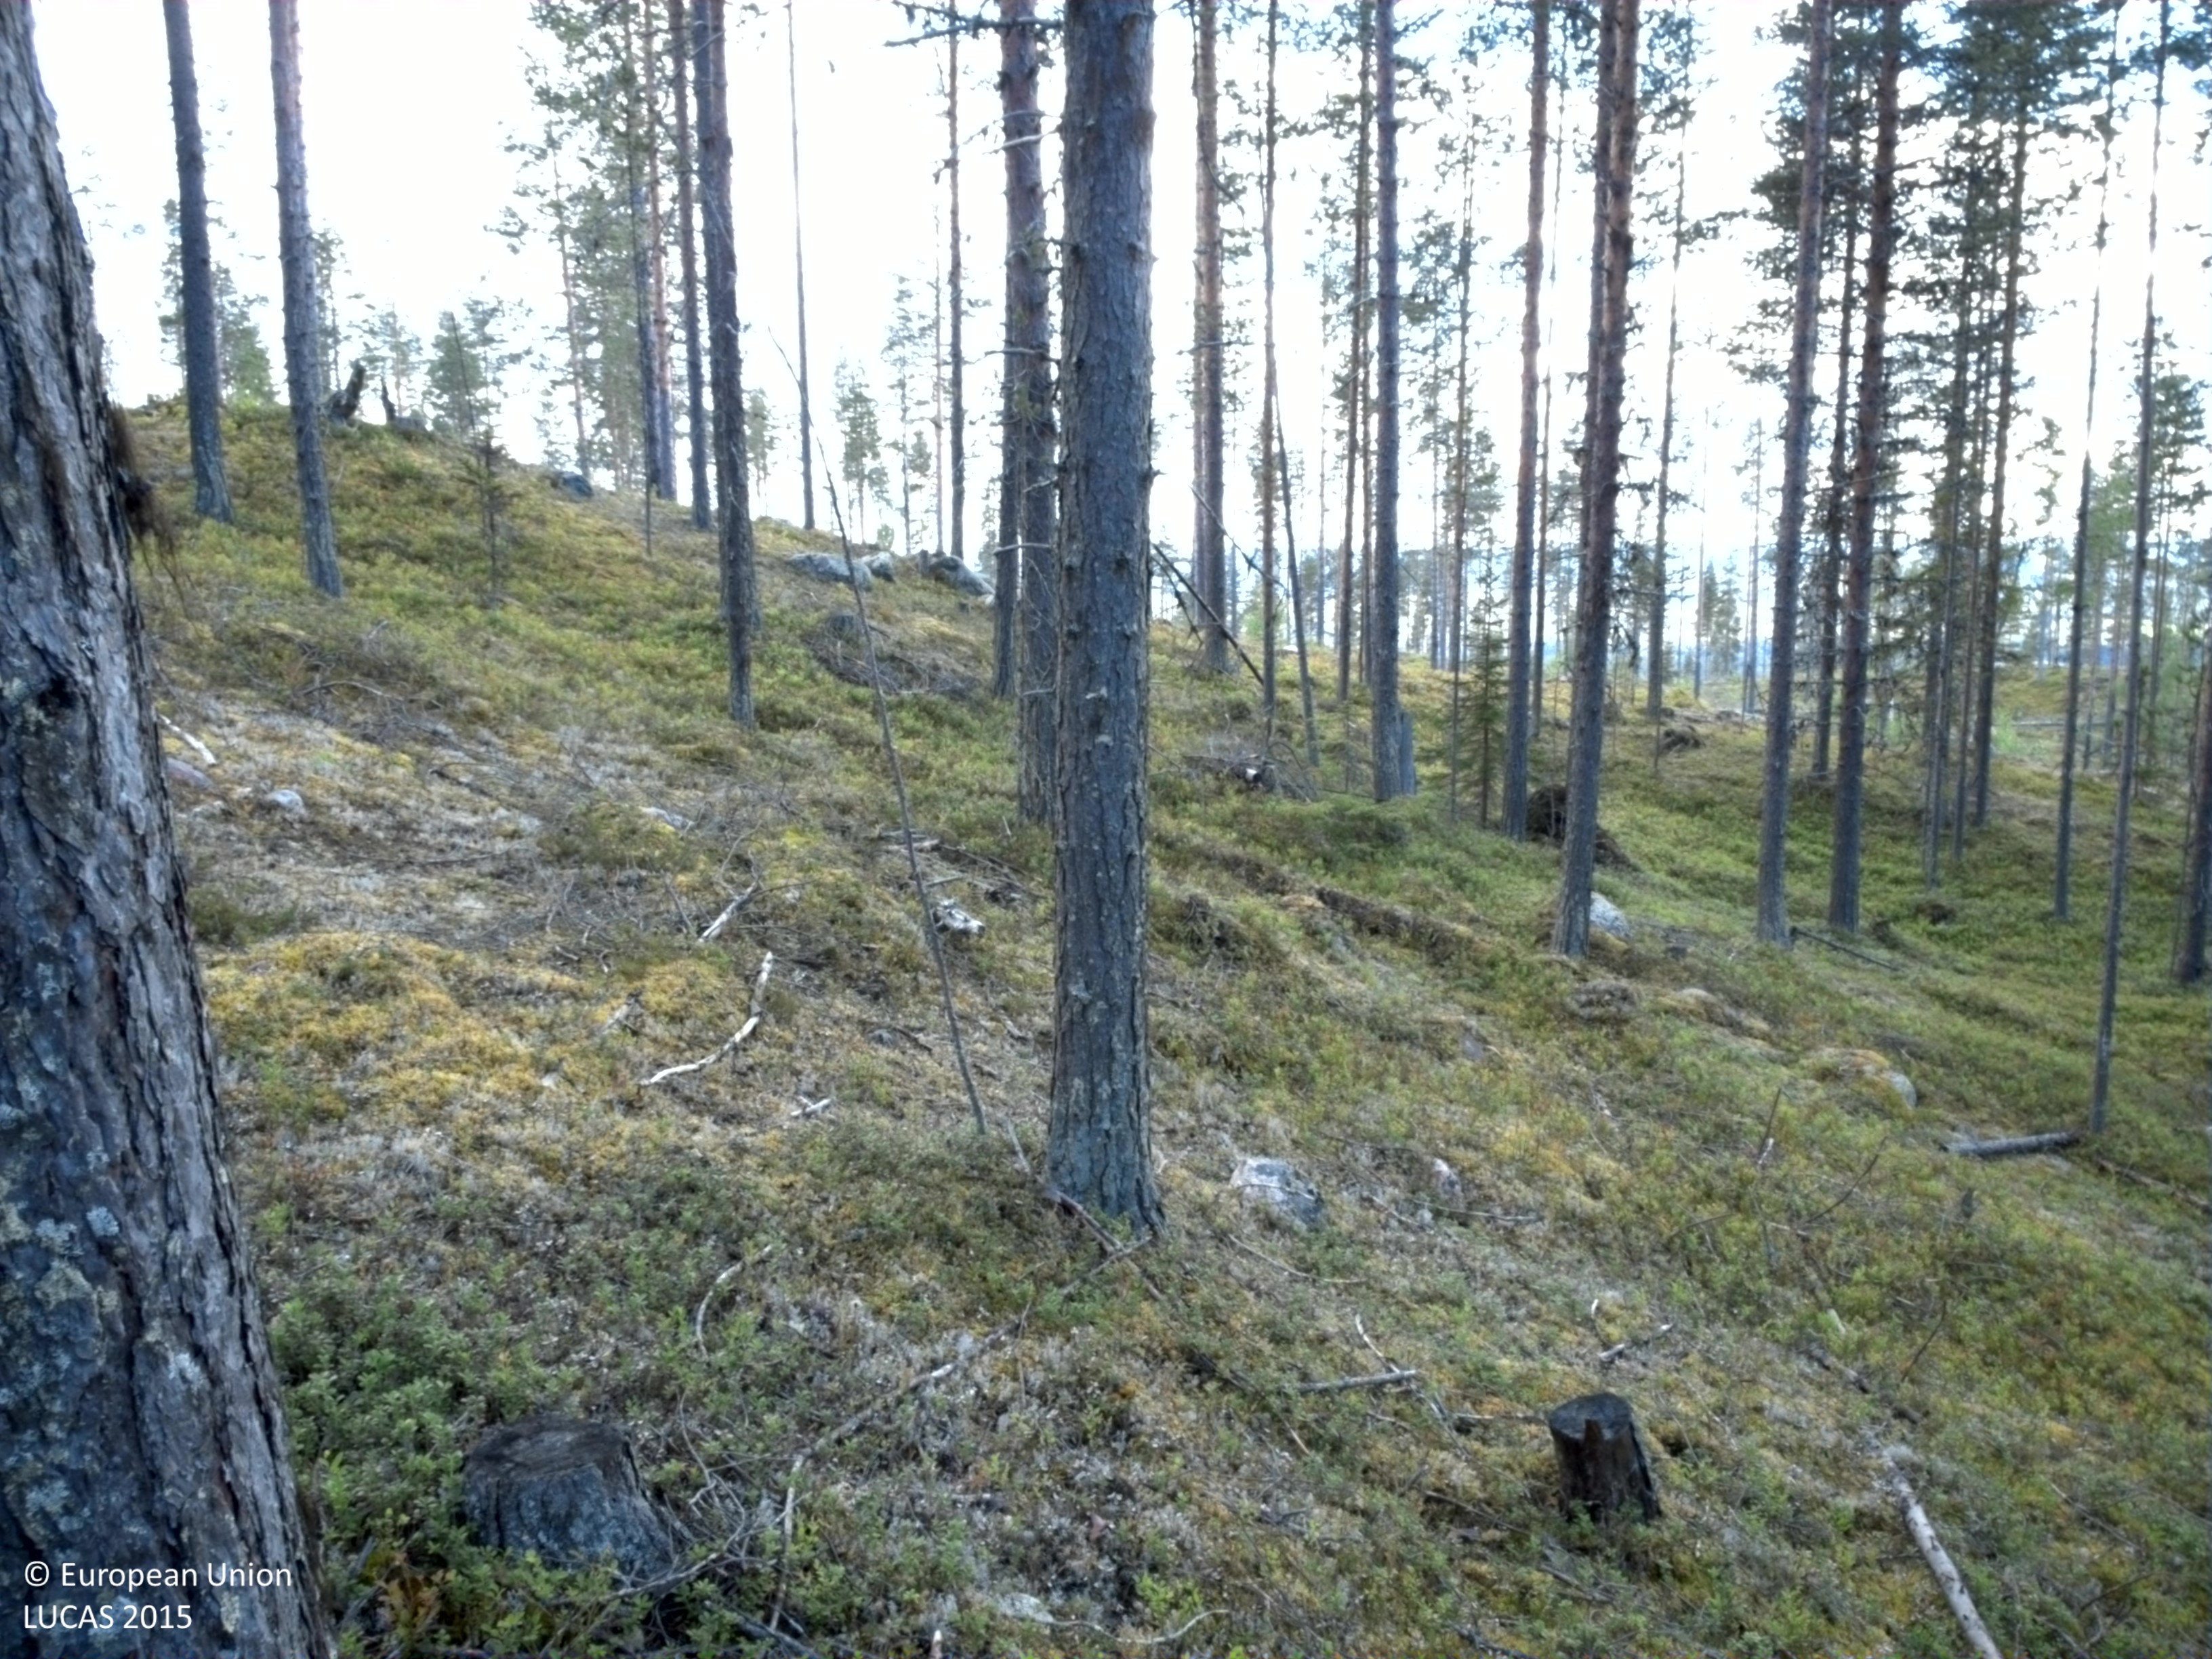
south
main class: Woodland
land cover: Pine dominated coniferous woodland
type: boreal forest
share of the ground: 25 - 50 %
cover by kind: shrubs 60 %, coniferous forest trees 30 %, lichens and mosses 5 %, consolidated bare surface 5 %
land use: Forestry
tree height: > 5 m
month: August
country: SE
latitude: 66.4481
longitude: 20.7005
